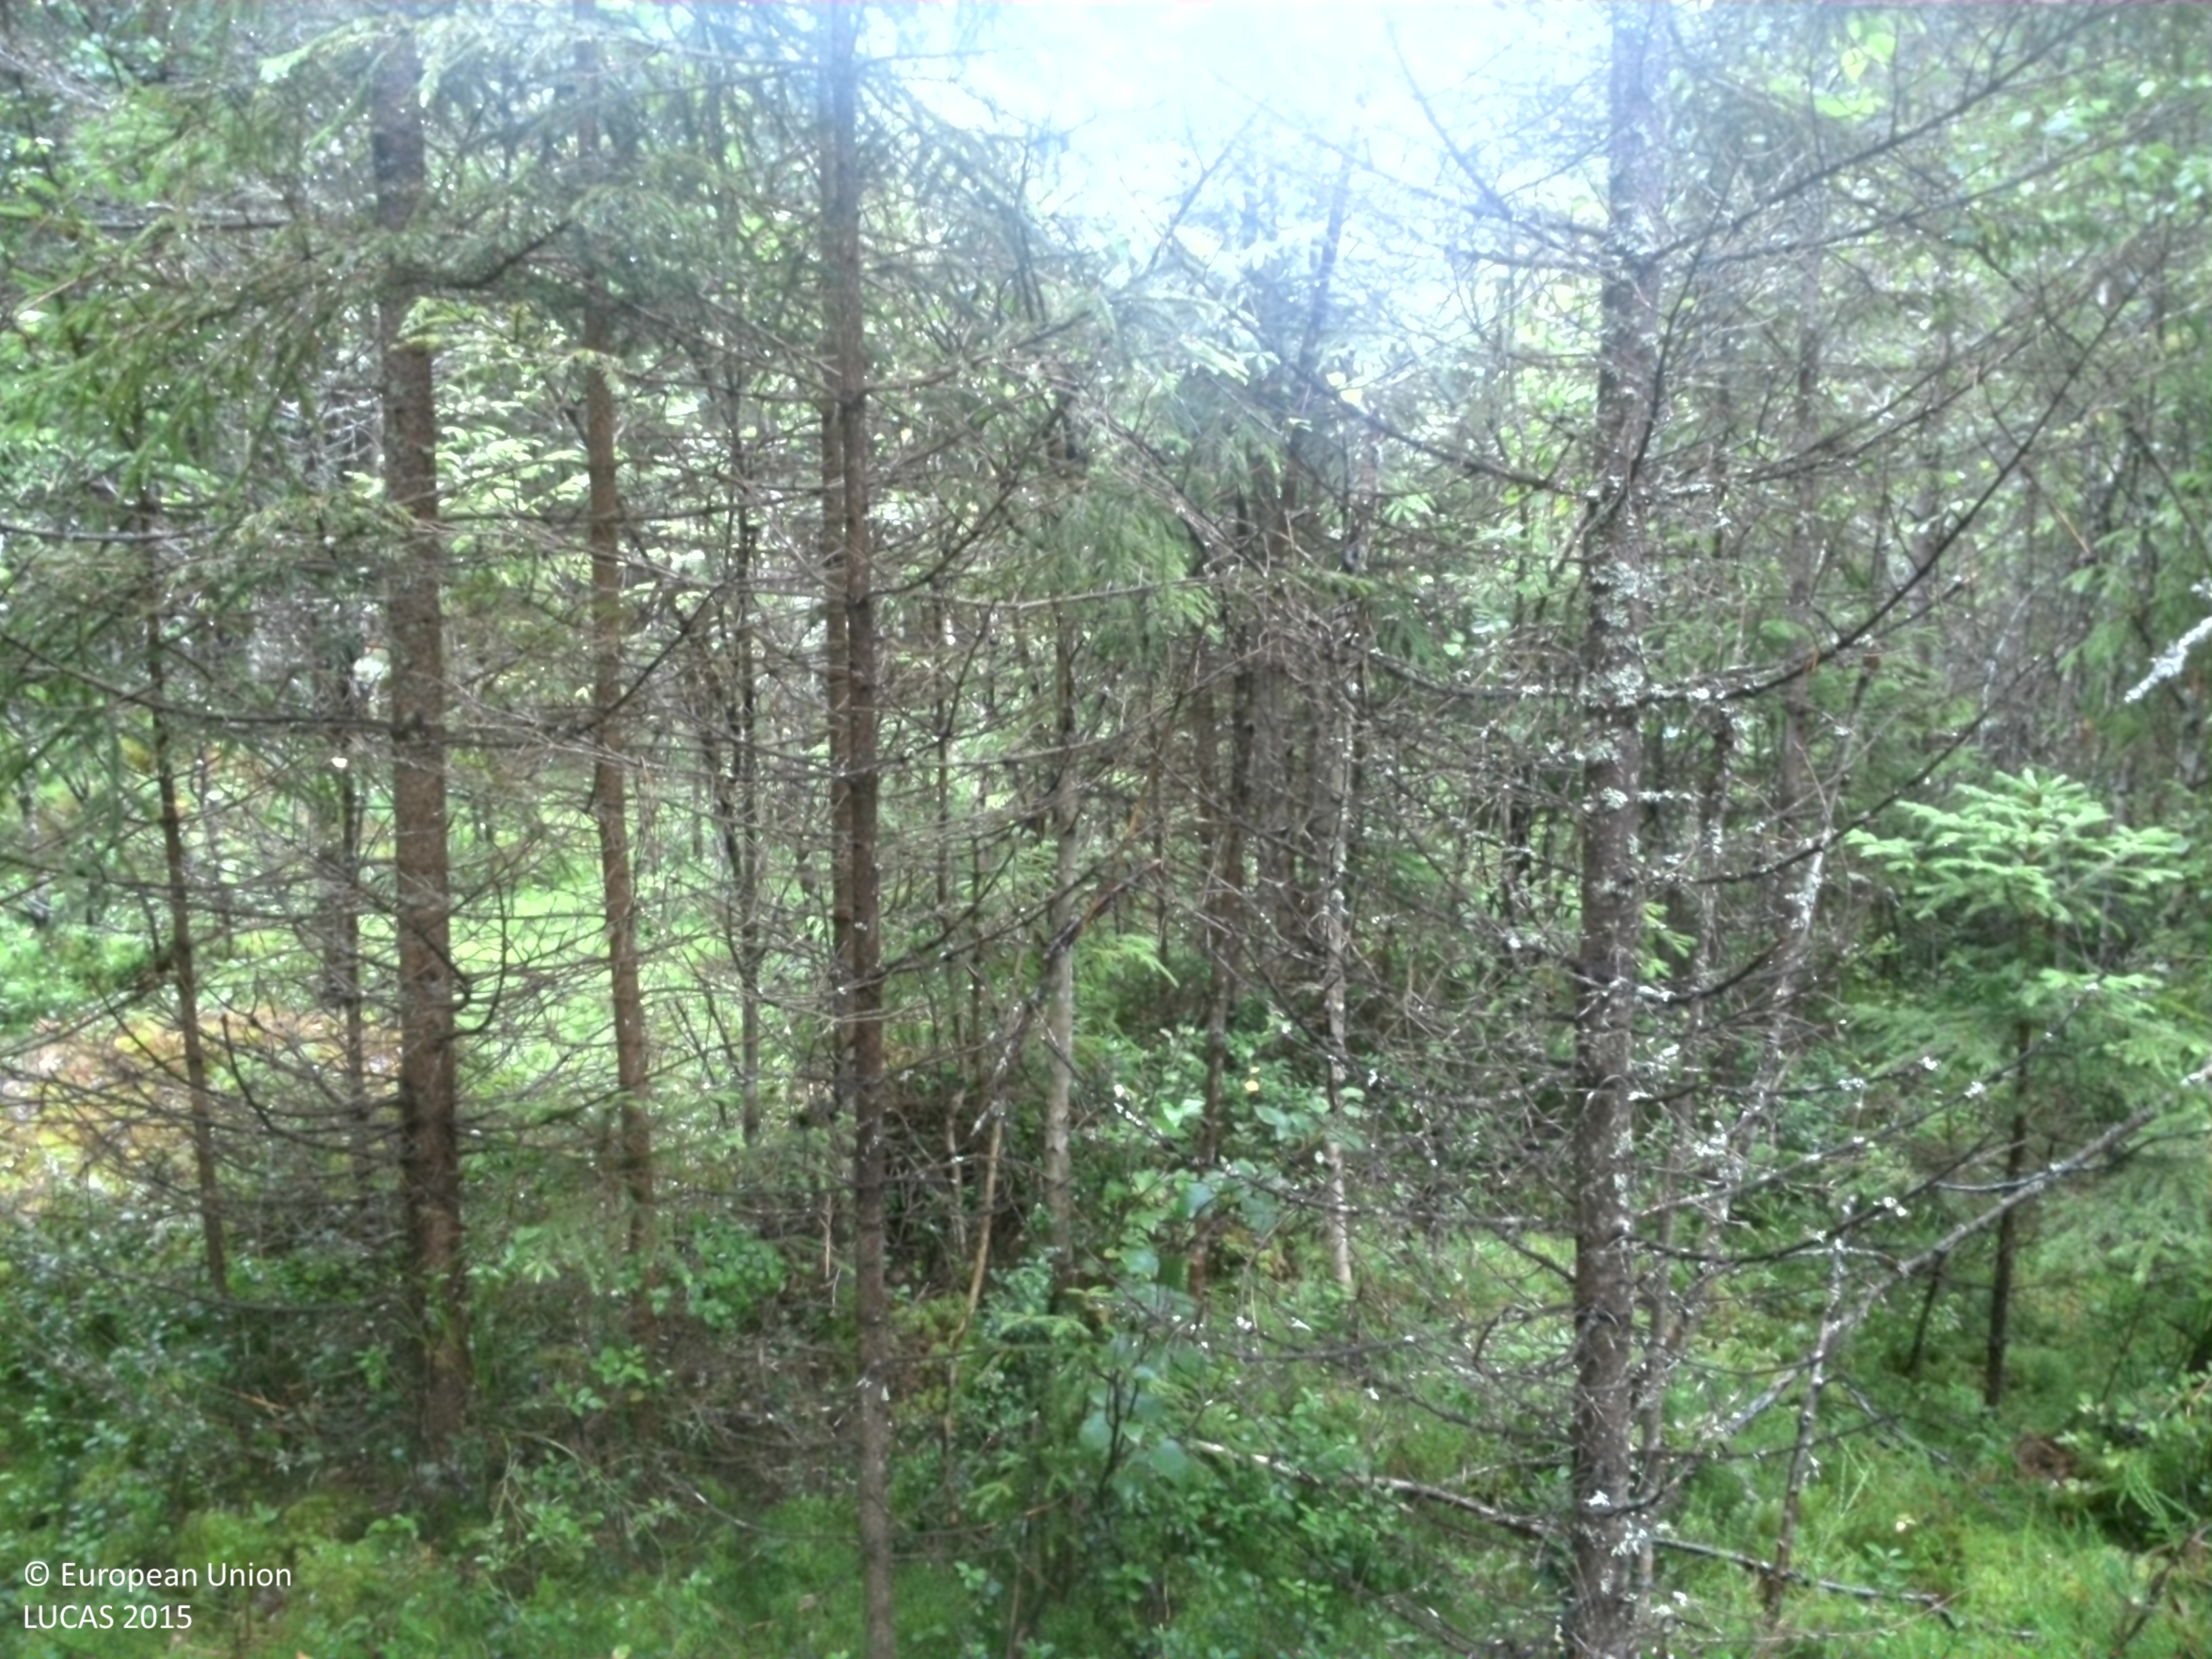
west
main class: Woodland
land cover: Other mixed woodland
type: boreal forest
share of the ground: 50 - 75 %
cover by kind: coniferous forest trees 45 %, broadleaved forest trees 20 %, lichens and mosses 15 %, shrubs 10 %, herbaceous plants 10 %
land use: Forestry
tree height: > 5 m
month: July
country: SE
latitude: 59.2725
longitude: 14.7115
